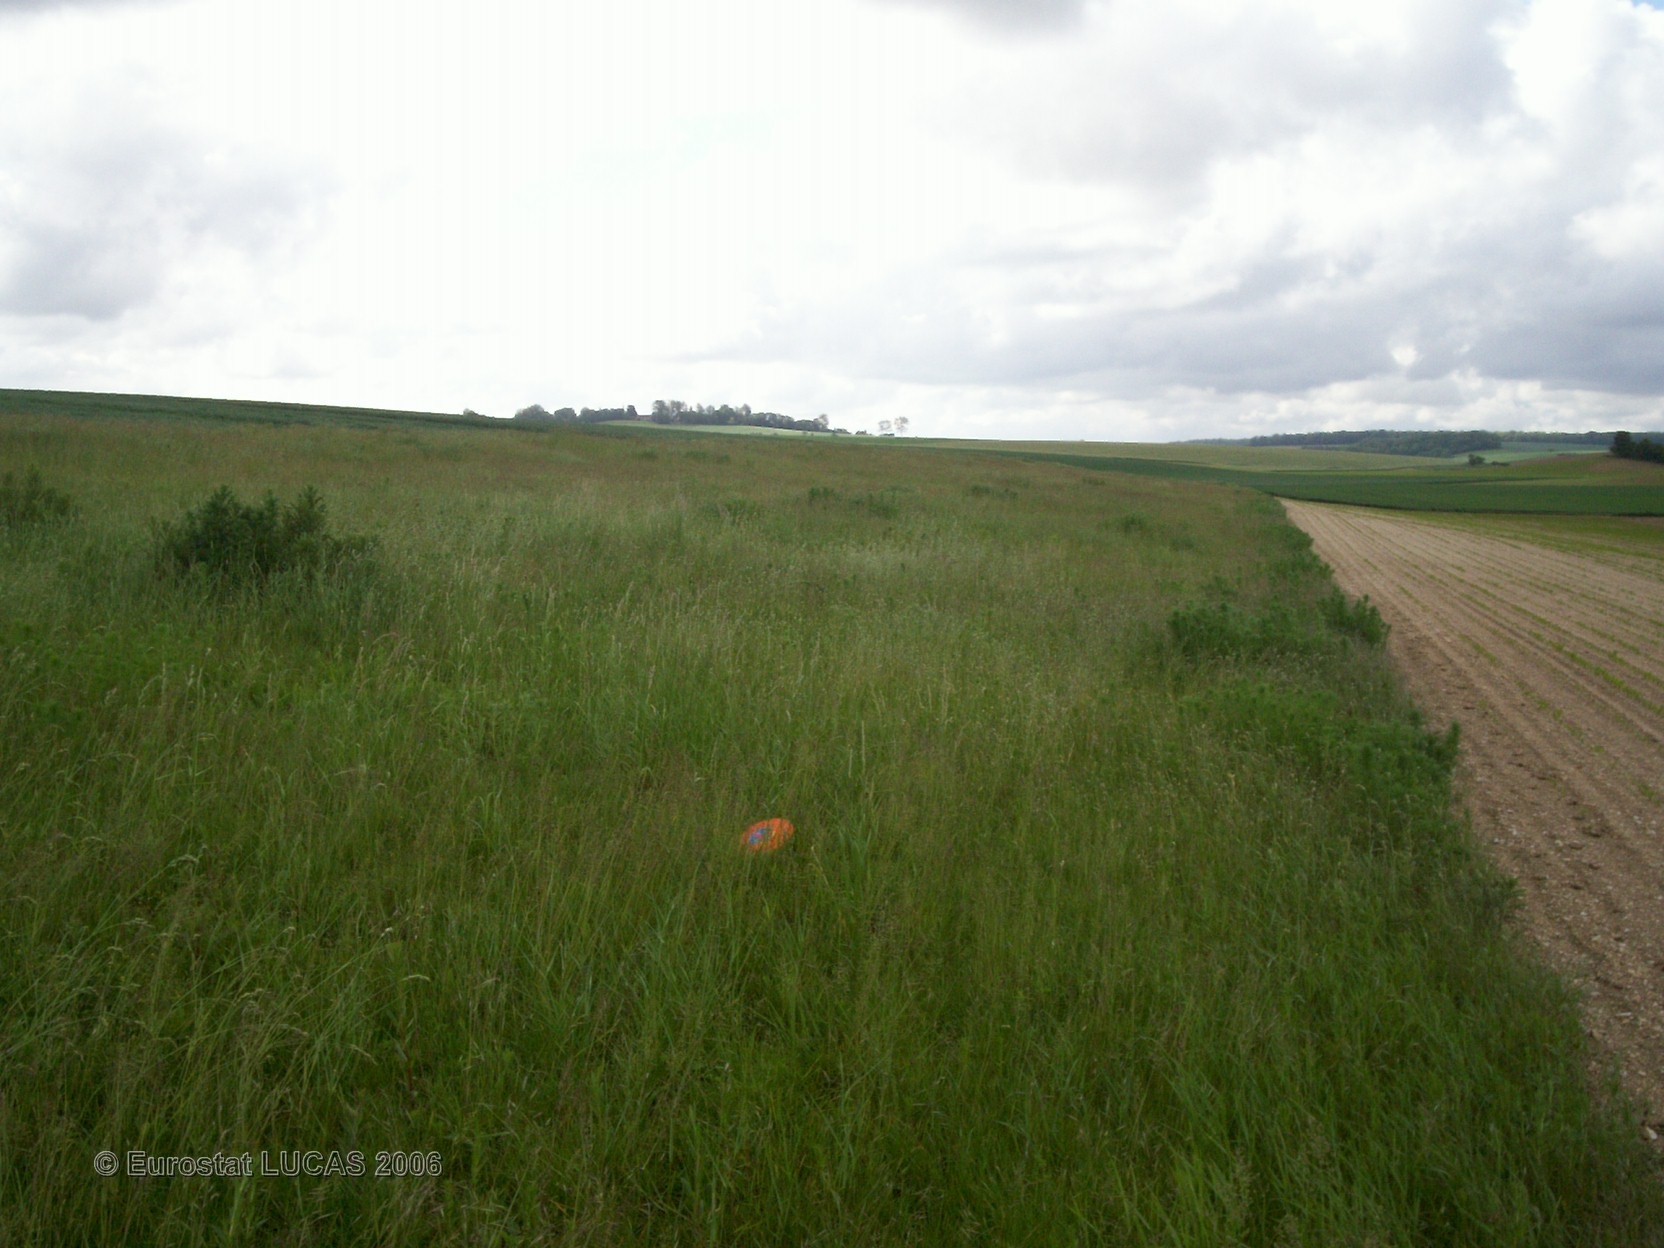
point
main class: Grassland
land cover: Grassland without tree/shrub cover
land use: Agriculture (excluding fallow land and kitchen gardens)
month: May
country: FR
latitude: 49.7726
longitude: 3.6475
